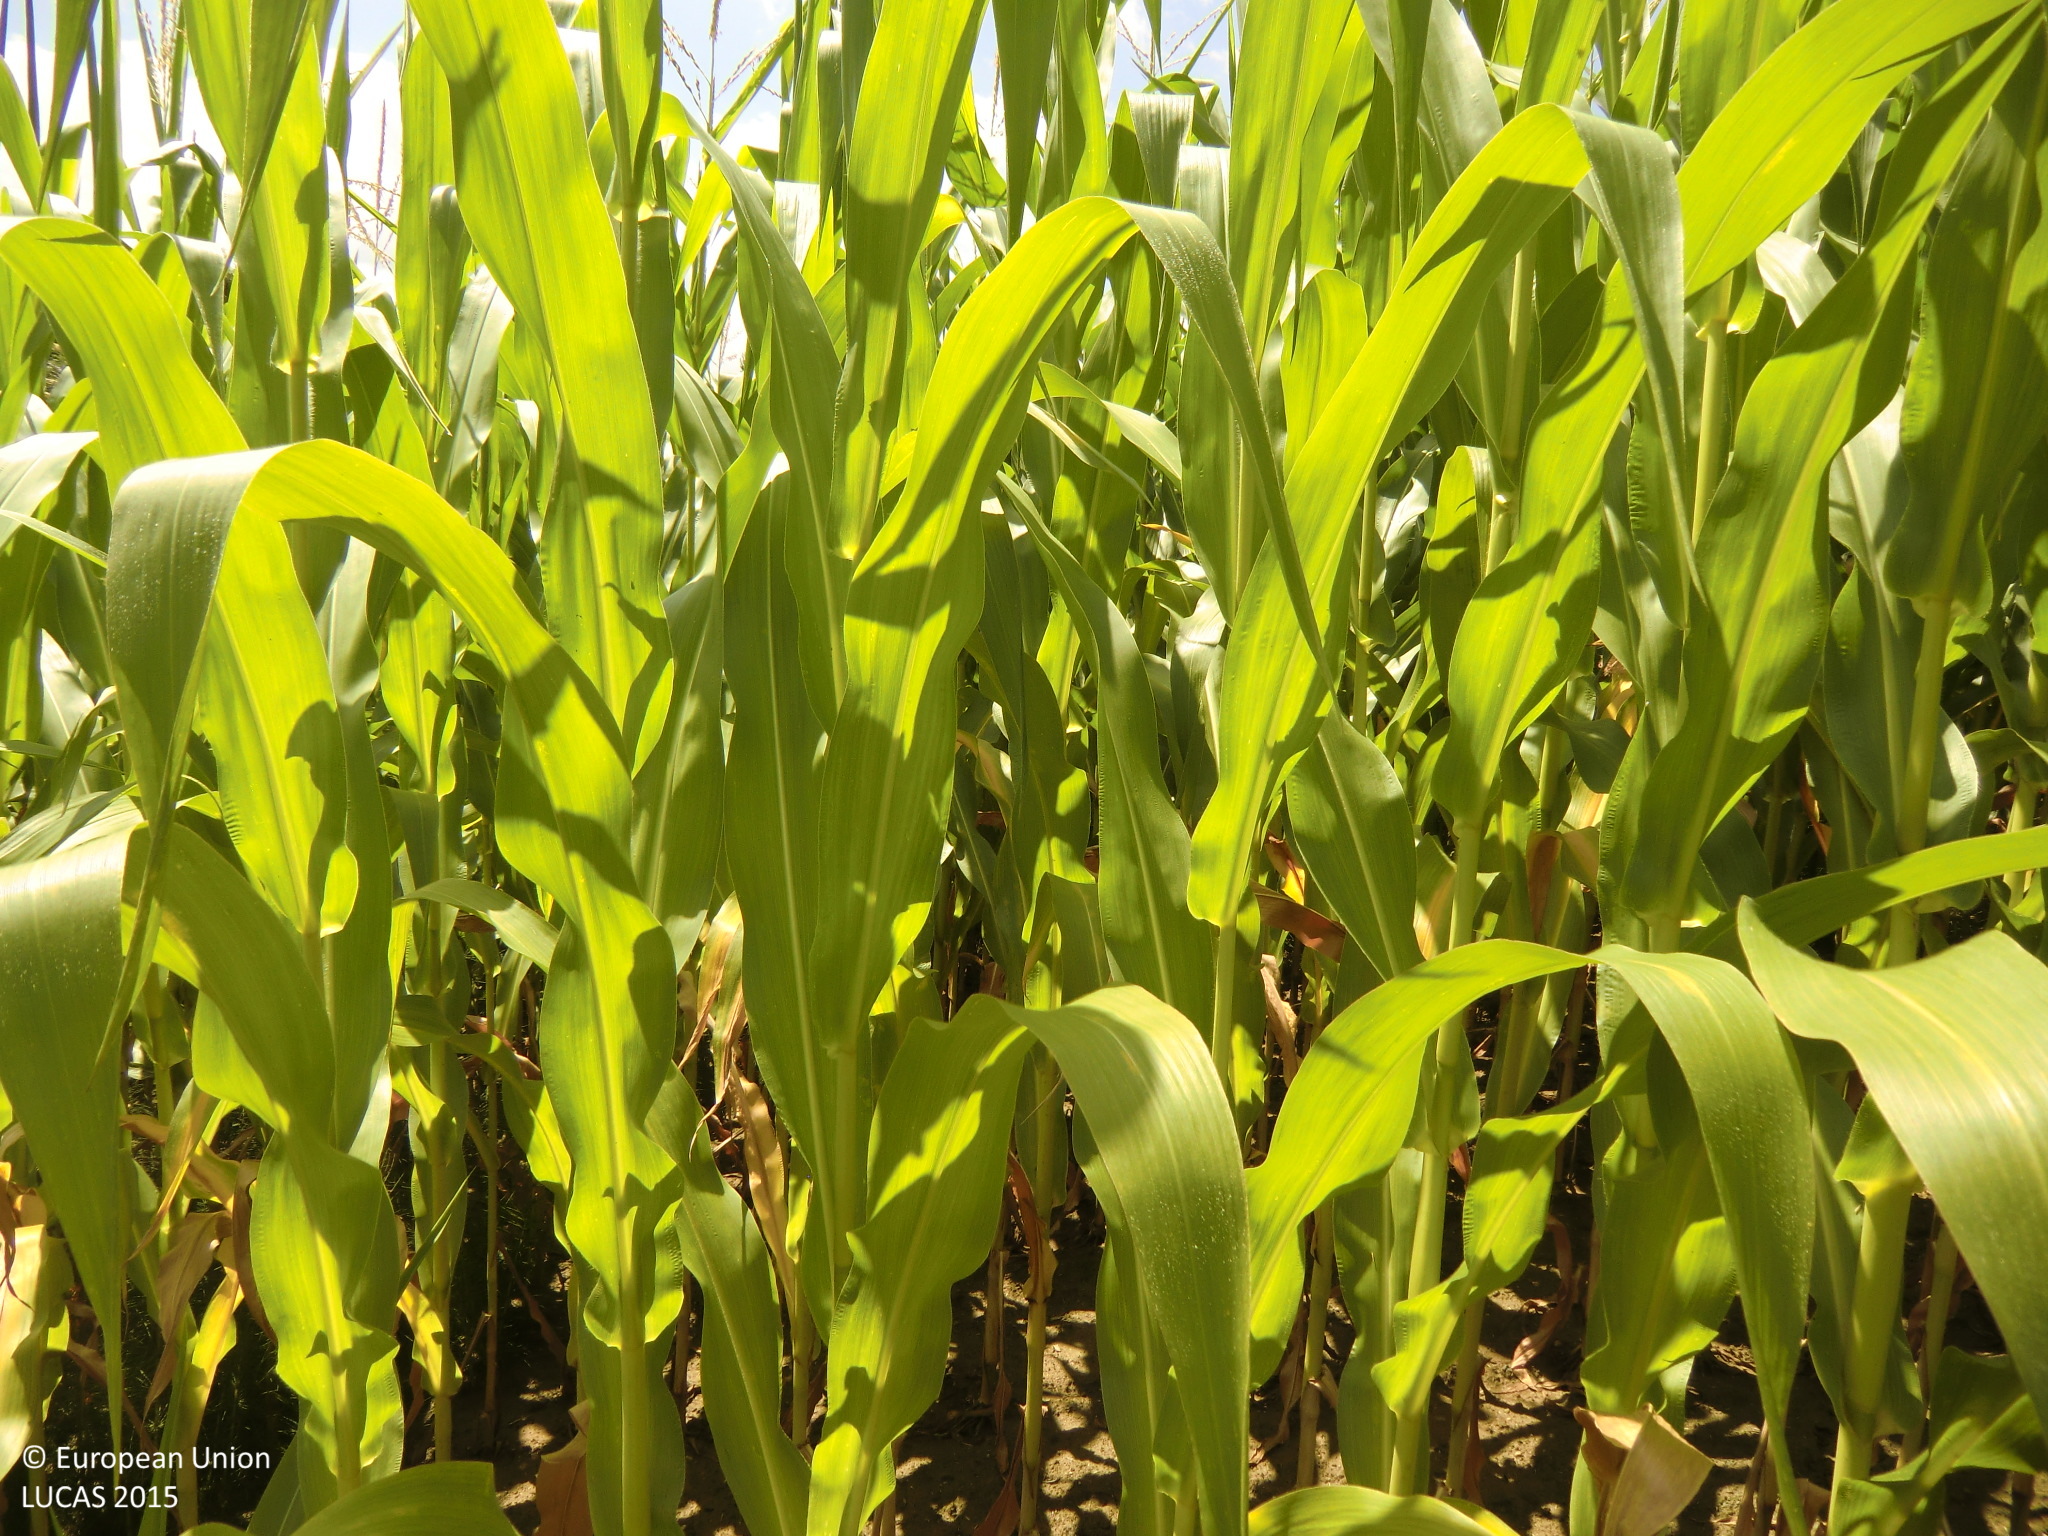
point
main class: Cropland
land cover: Maize
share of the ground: > 75 %
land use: Agriculture (excluding fallow land and kitchen gardens)
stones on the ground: < 10 %
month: July
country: AT
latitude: 46.9888
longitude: 16.1153
